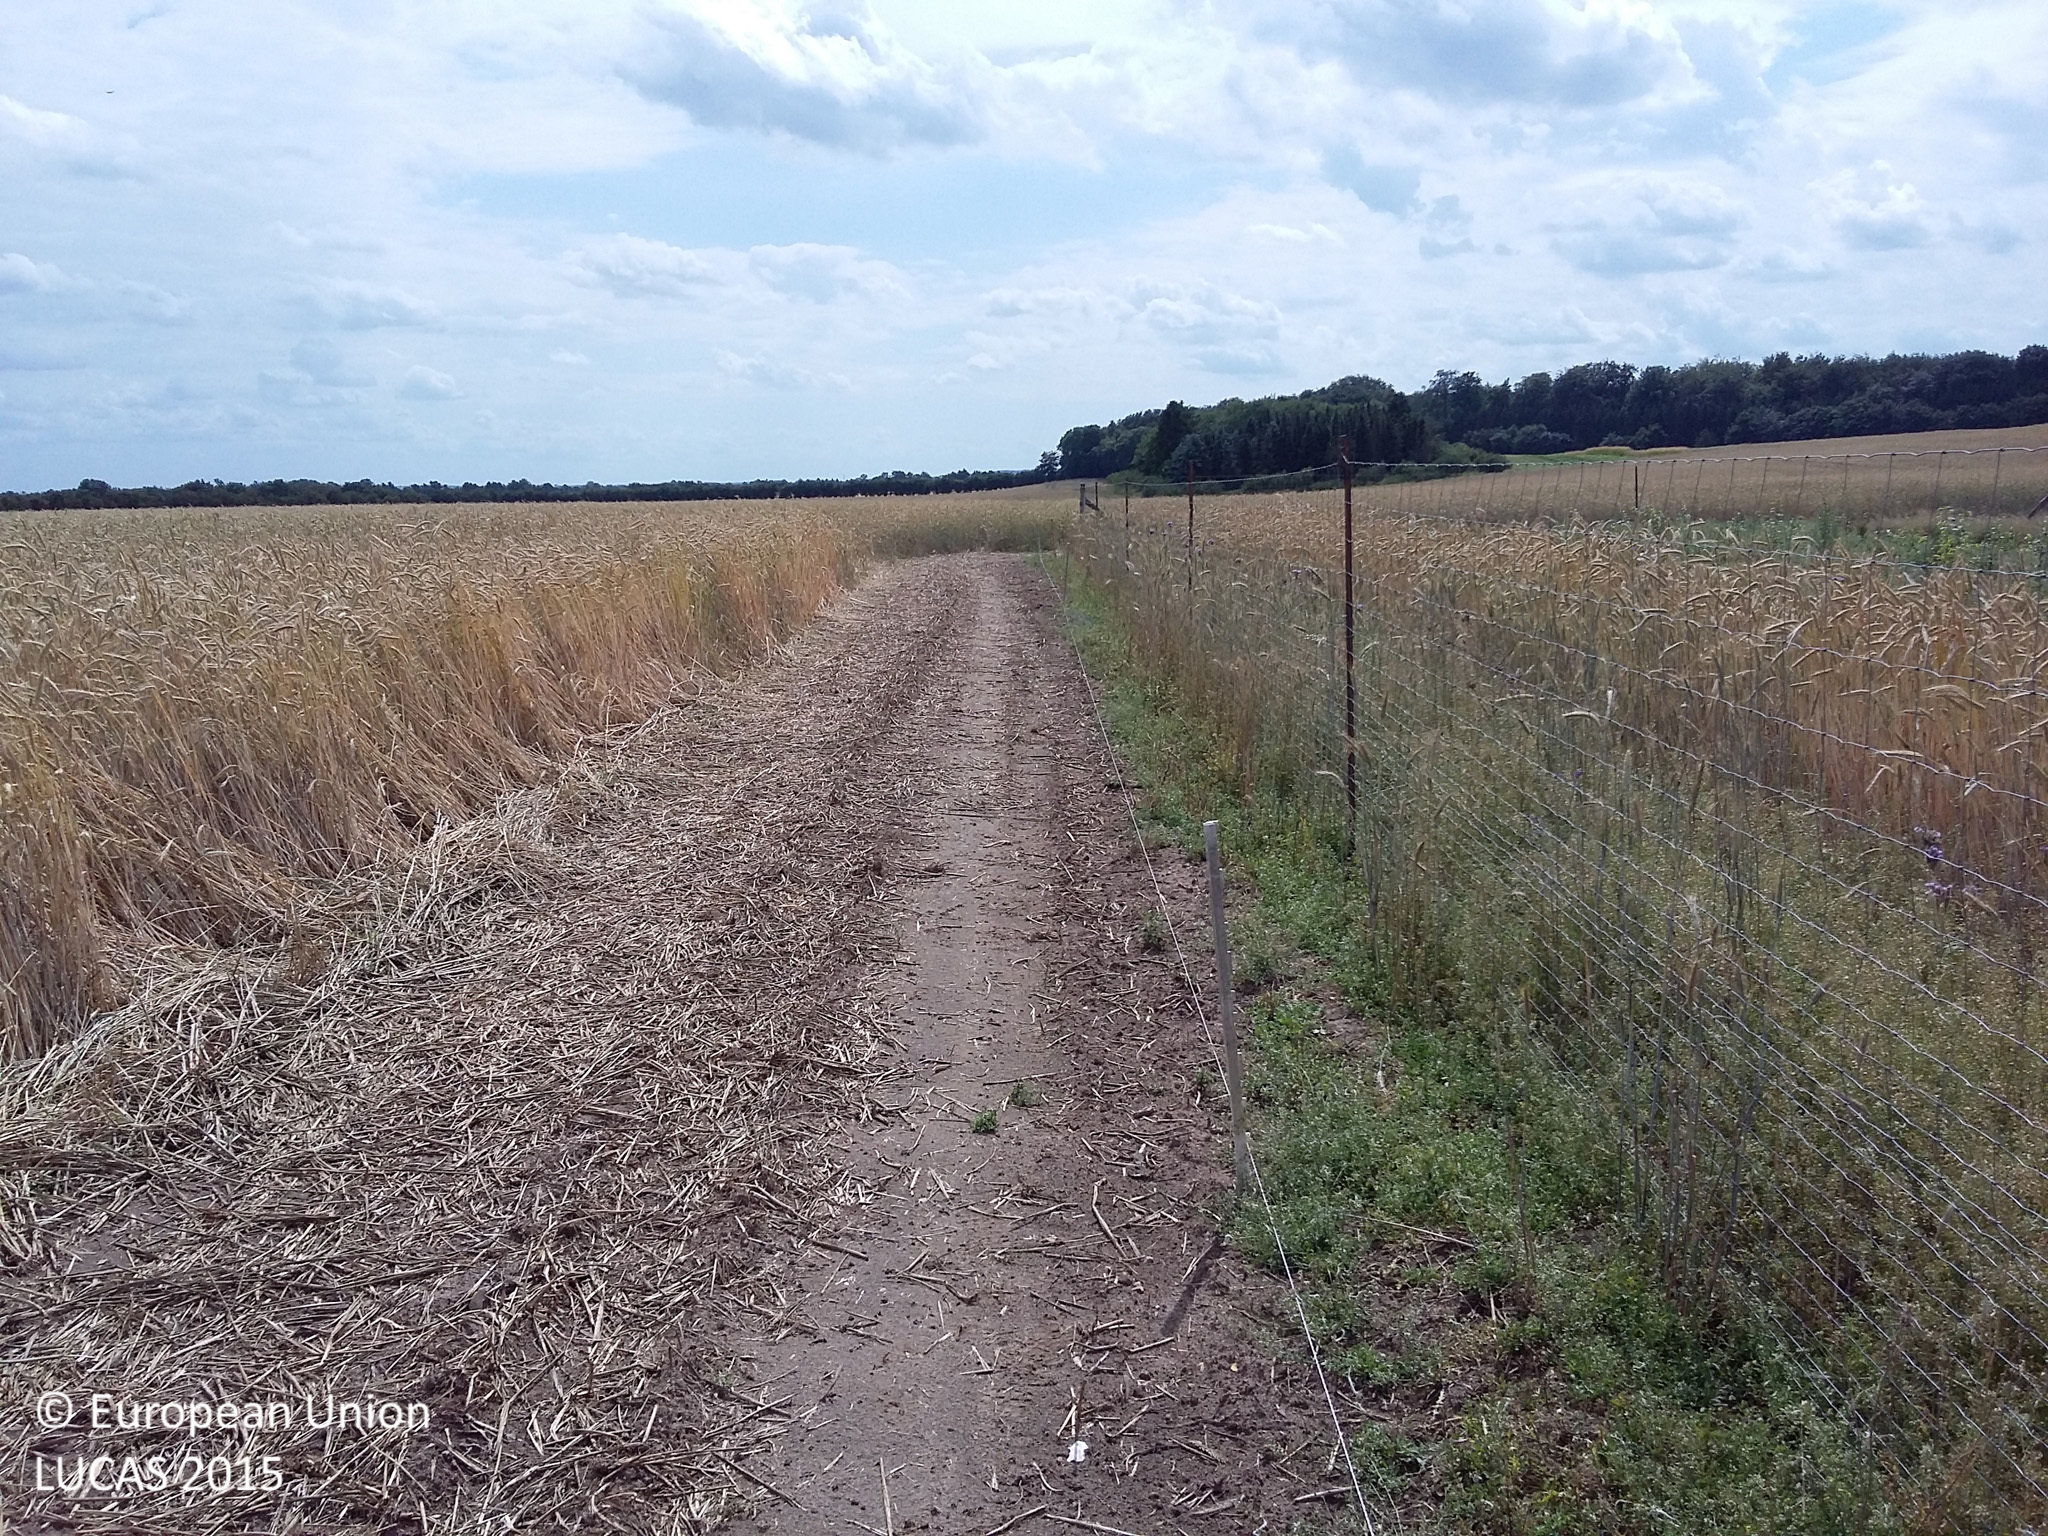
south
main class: Cropland
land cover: Cherry fruit
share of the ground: 25 - 50 %
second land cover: Spontaneously vegetated surfaces
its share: 10 - 25 %
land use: Agriculture (excluding fallow land and kitchen gardens)
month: July
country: DK
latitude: 55.7233
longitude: 11.9565
